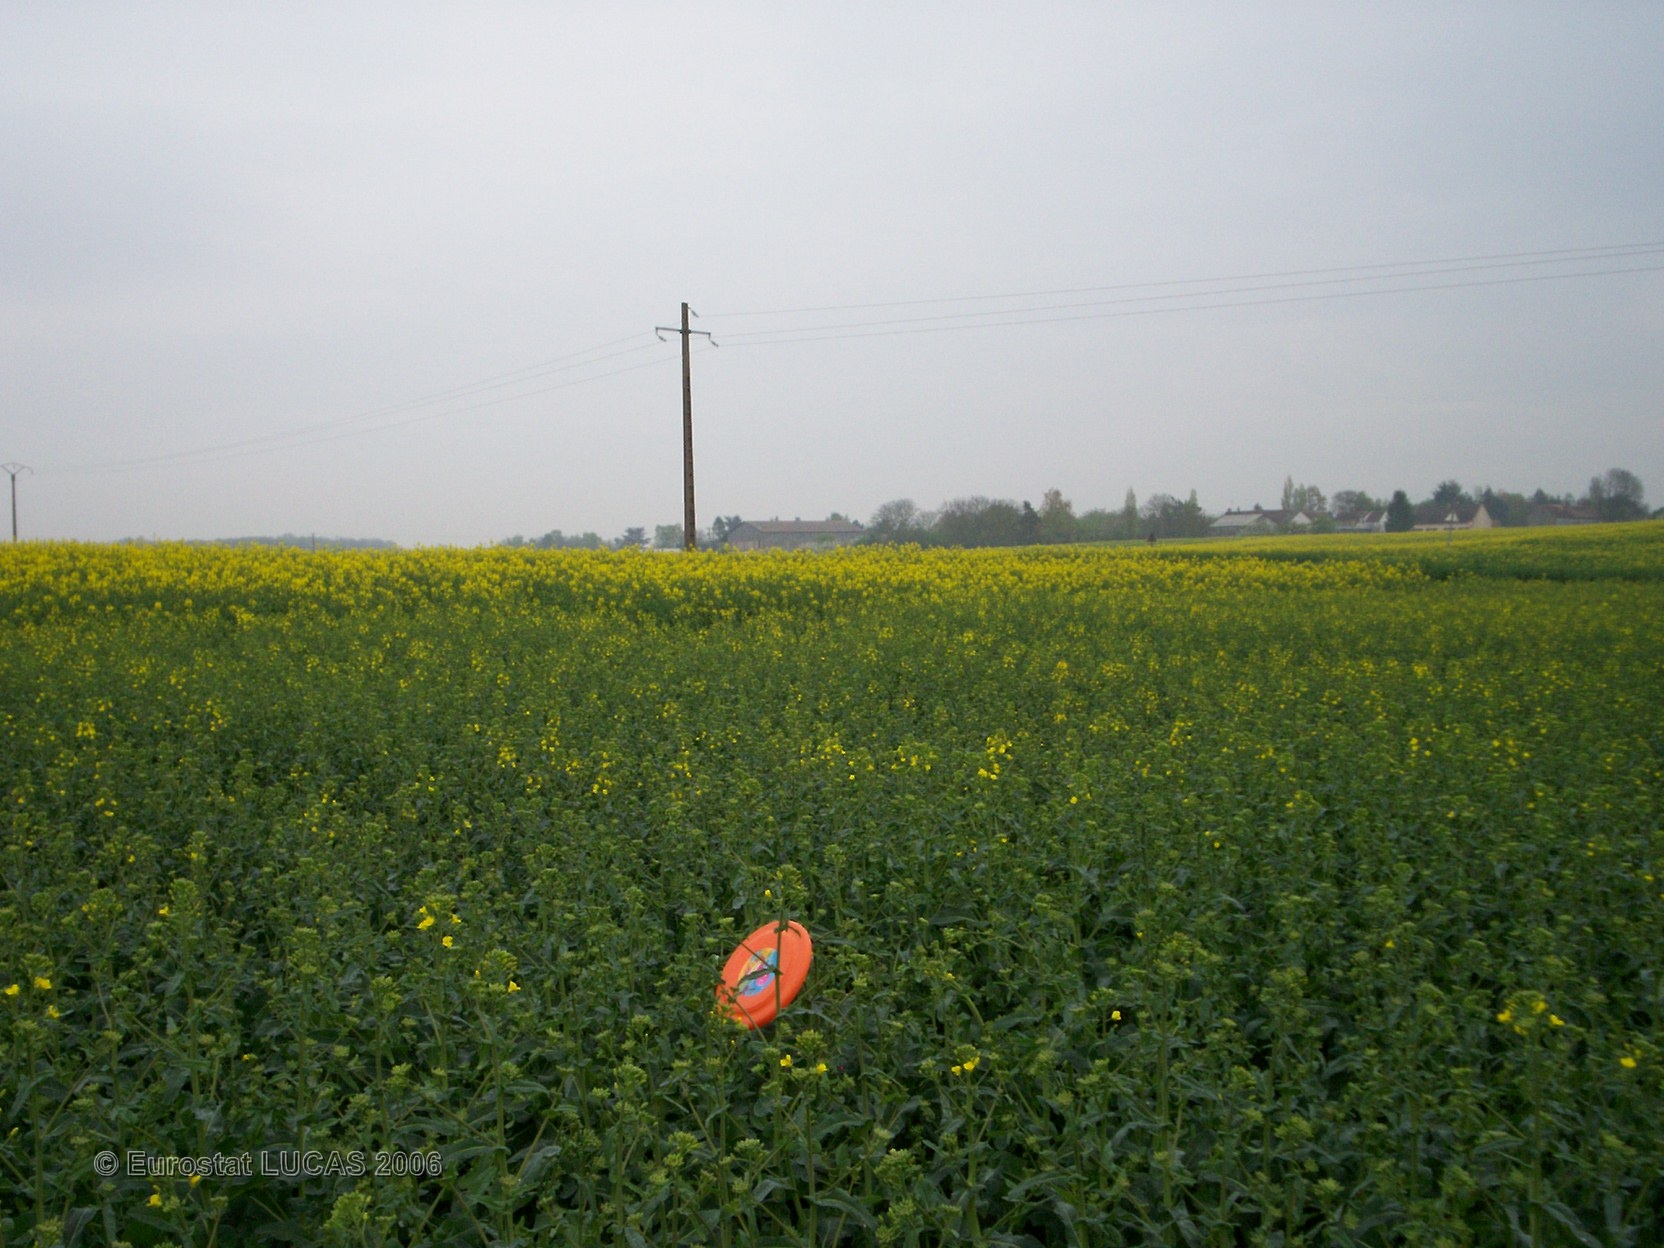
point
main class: Cropland
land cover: Rape and turnip rape
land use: Agriculture (excluding fallow land and kitchen gardens)
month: April
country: FR
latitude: 48.2222
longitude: 2.7901
